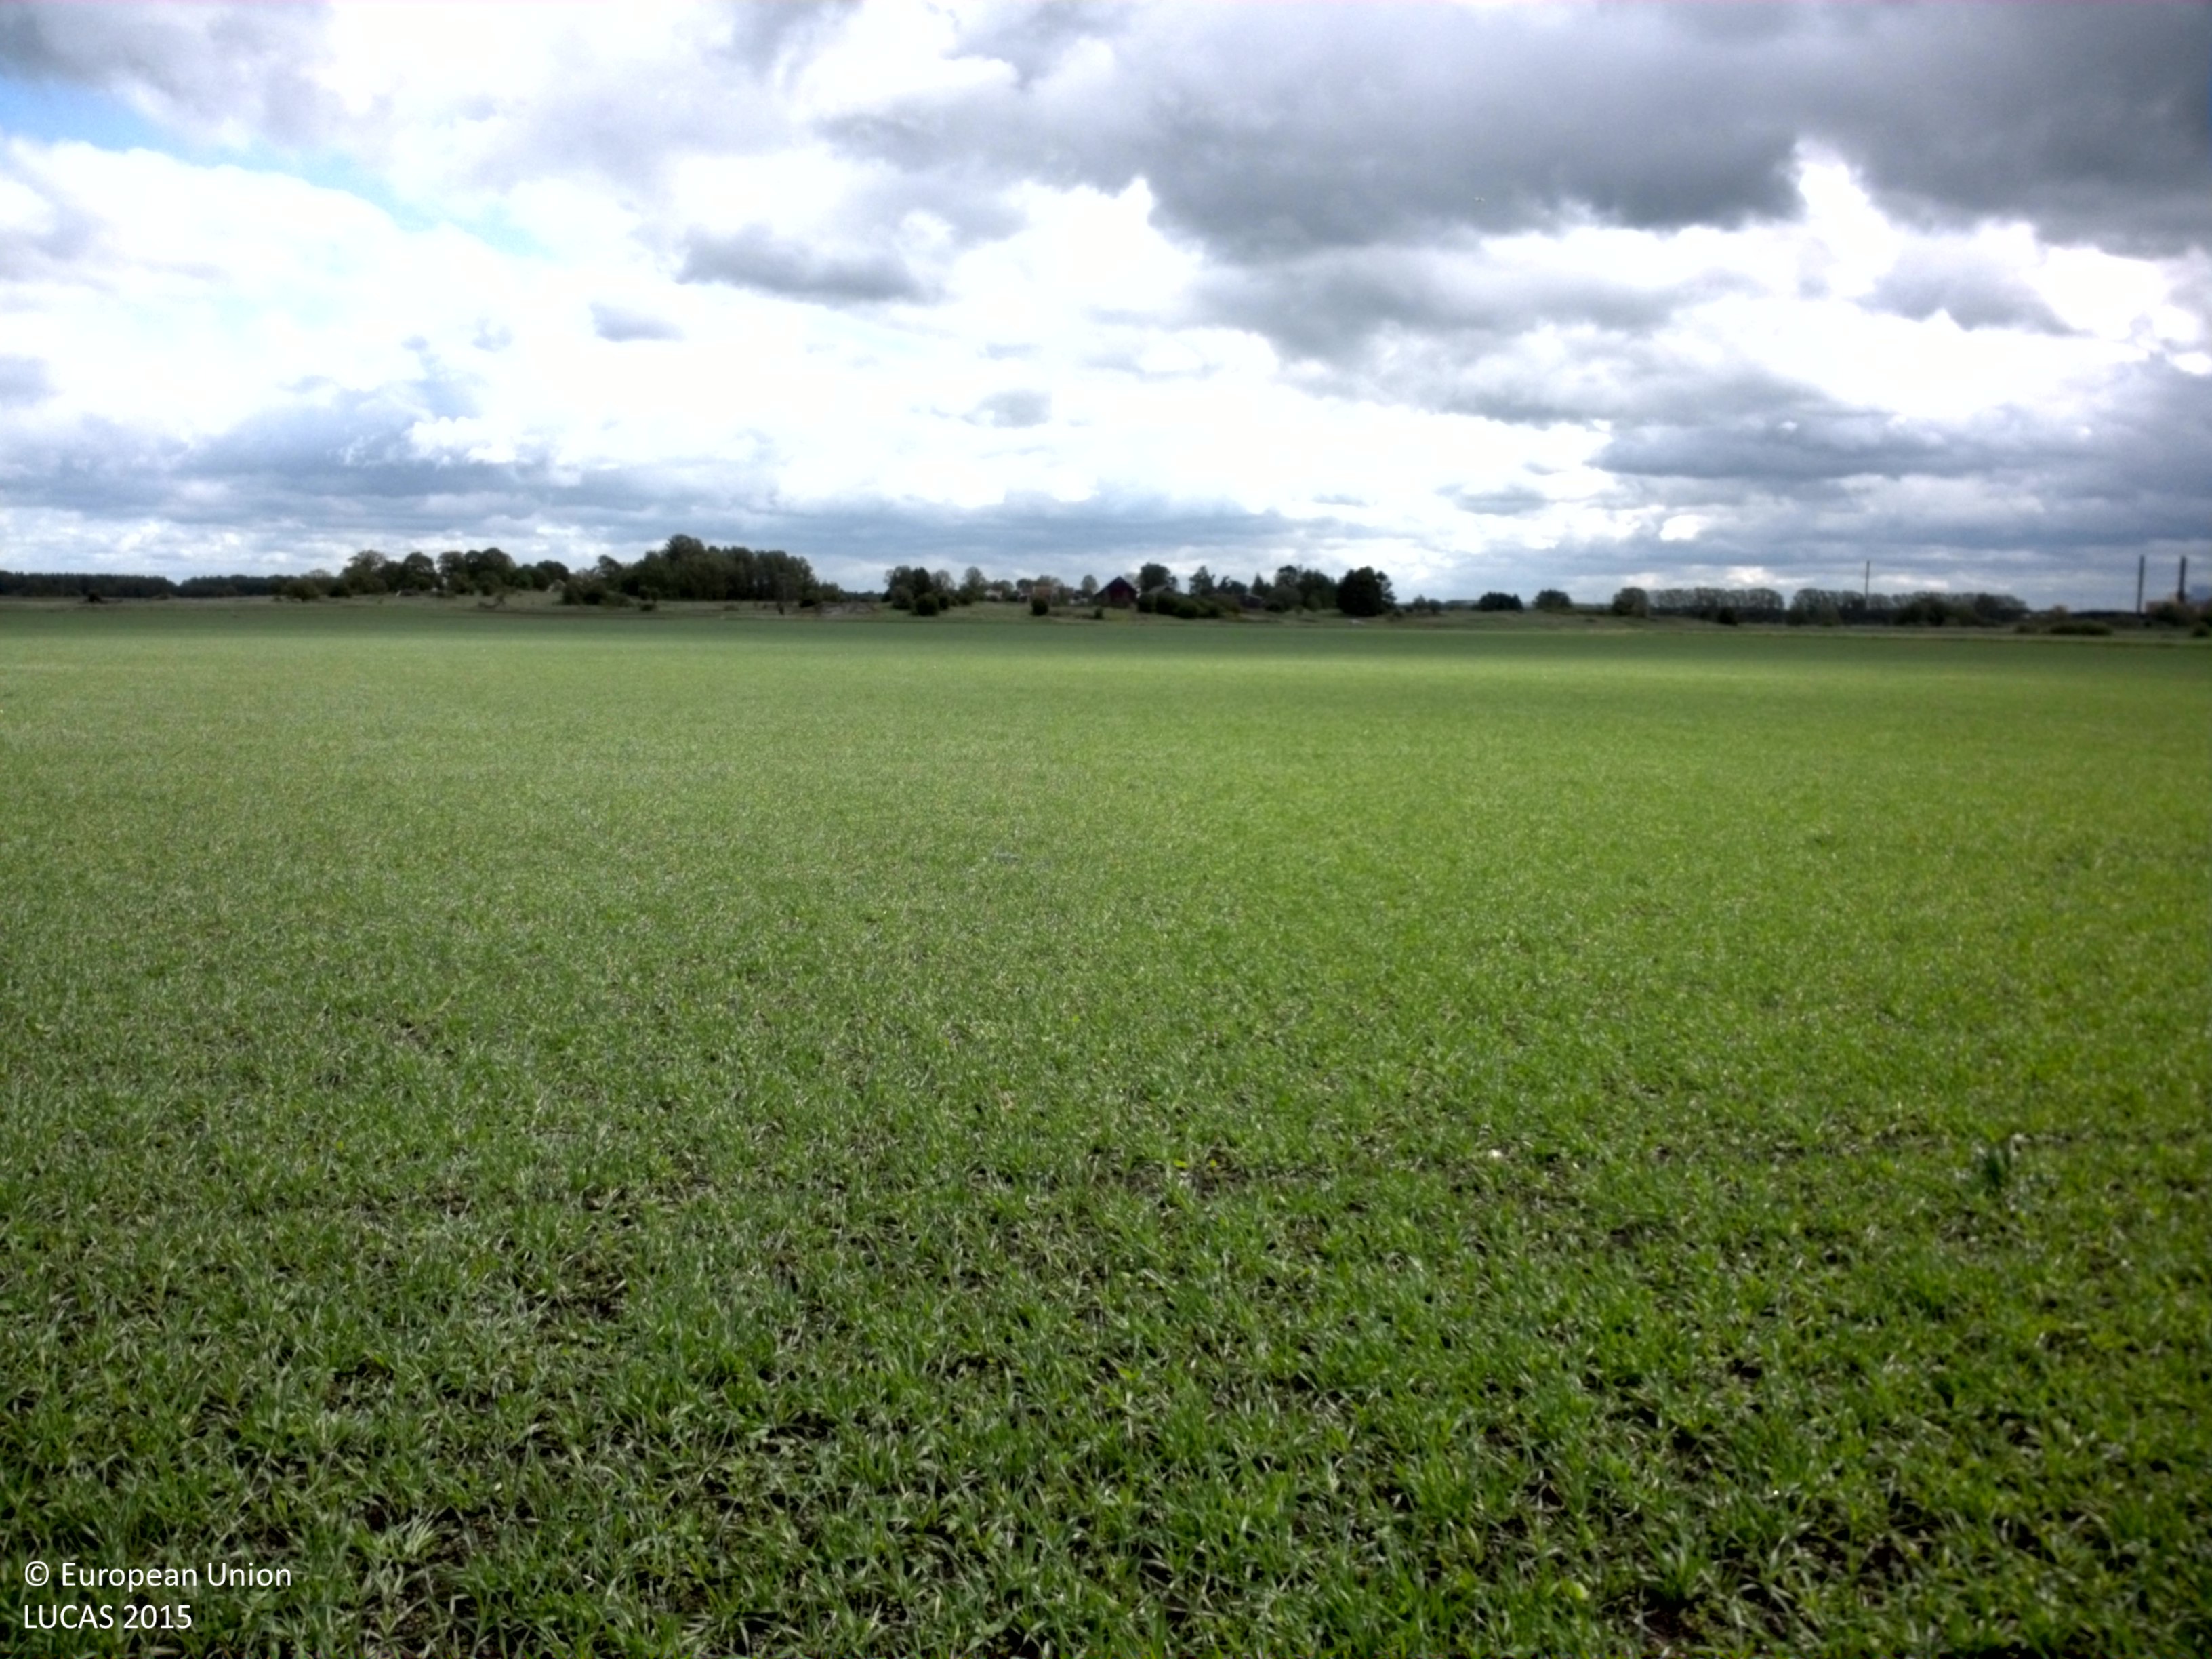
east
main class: Cropland
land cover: Common wheat
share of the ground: 50 - 75 %
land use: Agriculture (excluding fallow land and kitchen gardens)
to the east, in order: Common wheat
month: June
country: SE
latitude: 58.4443
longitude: 15.6310
